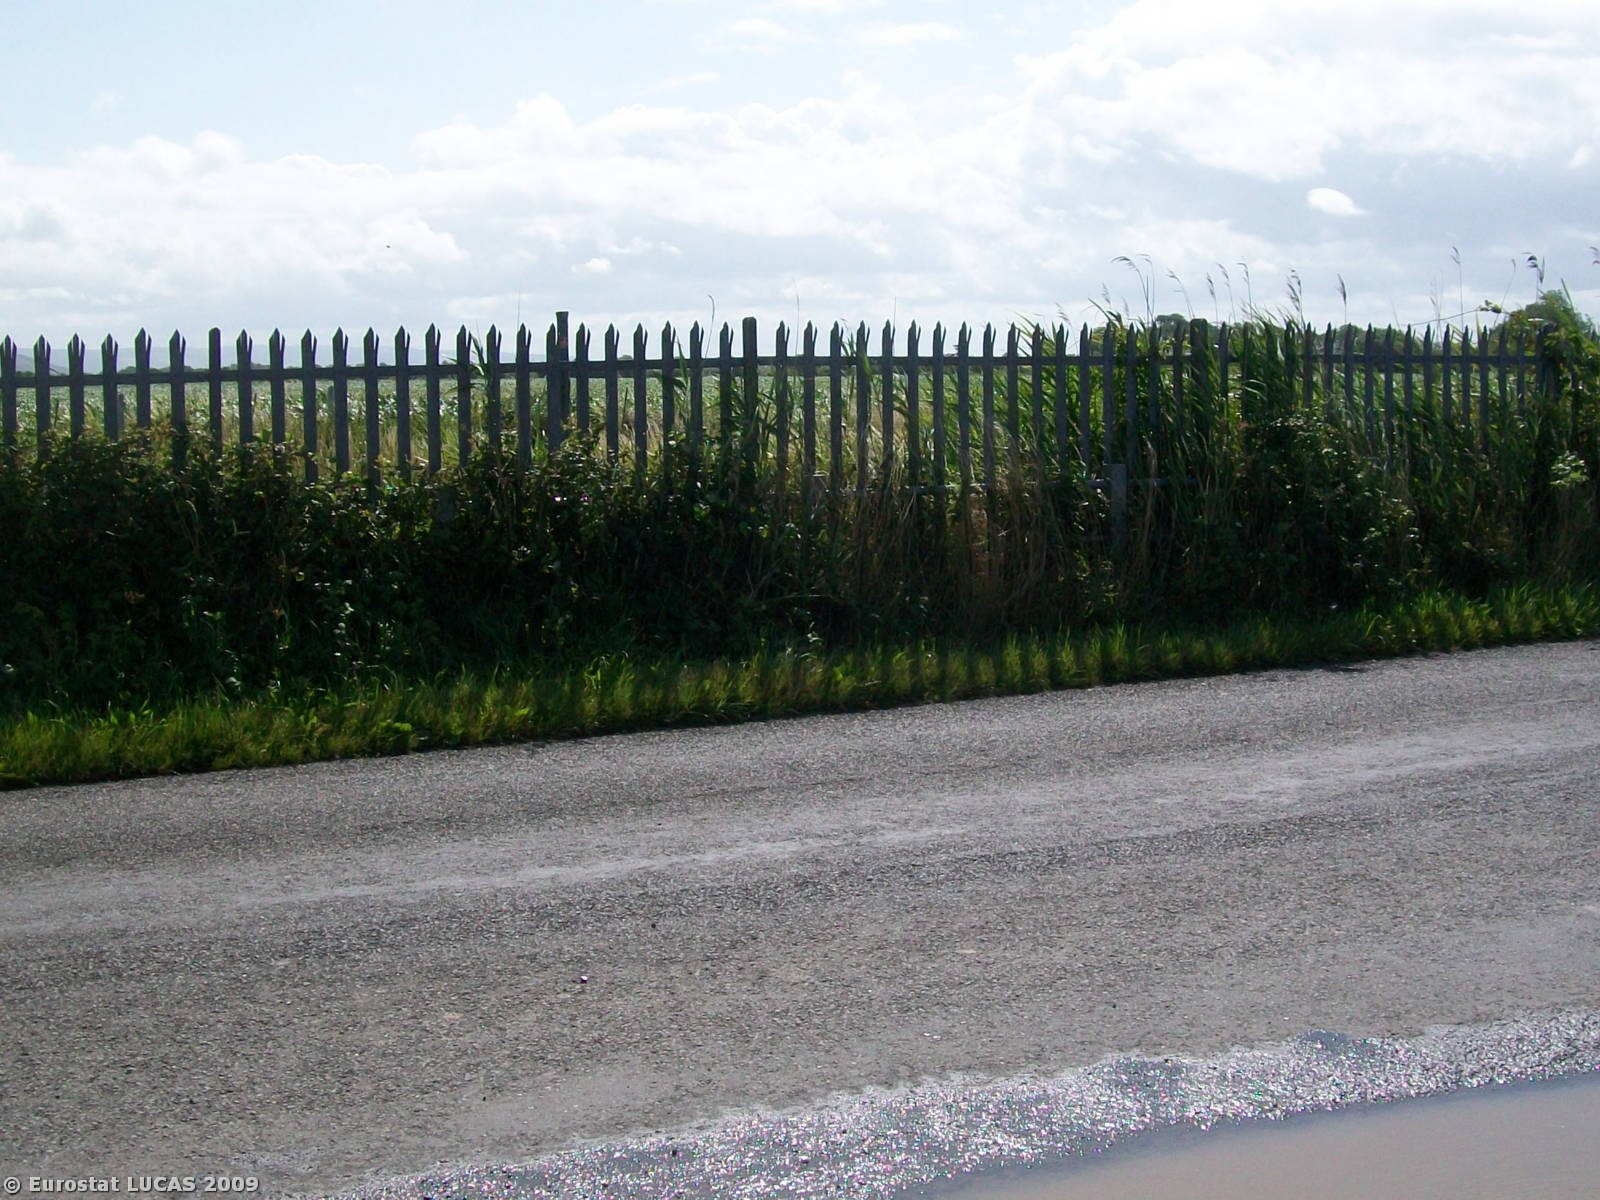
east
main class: Cropland
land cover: Maize
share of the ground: > 75 %
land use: Agriculture (excluding fallow land and kitchen gardens)
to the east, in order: Maize; Grassland without tree/shrub cover; Broadleaved woodland
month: July
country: GB
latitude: 51.2979
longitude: -2.9679
